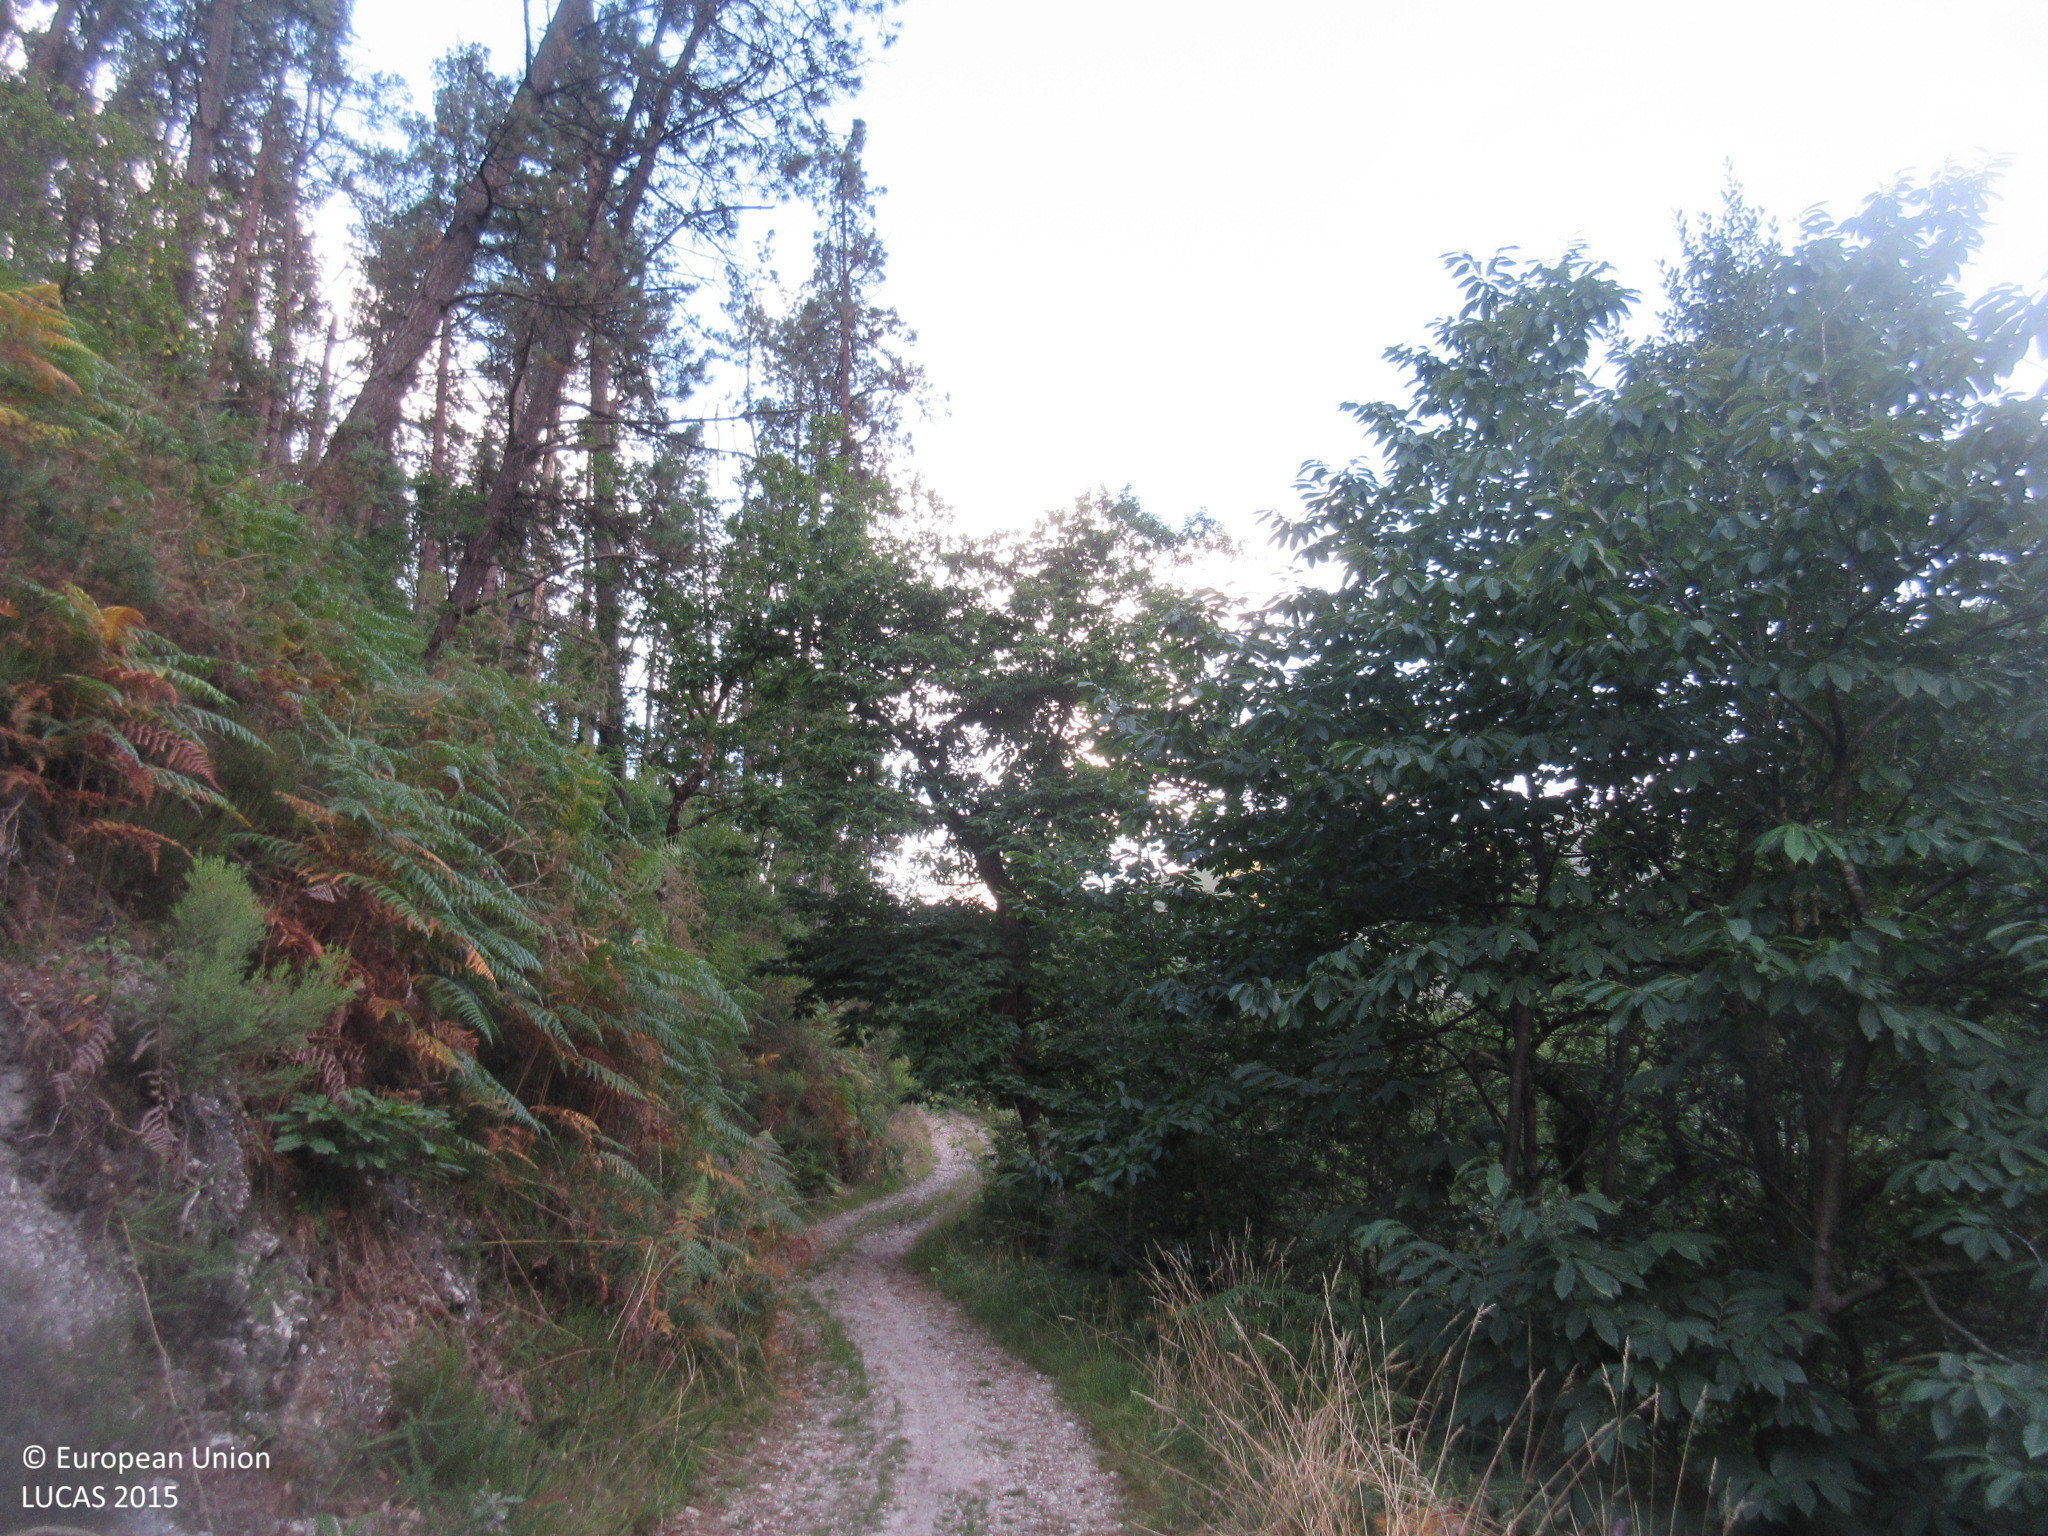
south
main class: Grassland
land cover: Grassland without tree/shrub cover
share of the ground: > 75 %
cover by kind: herbaceous plants 80 %, consolidated bare surface 20 %
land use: Agriculture (excluding fallow land and kitchen gardens)
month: July
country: ES
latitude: 43.3854
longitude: -5.0947
